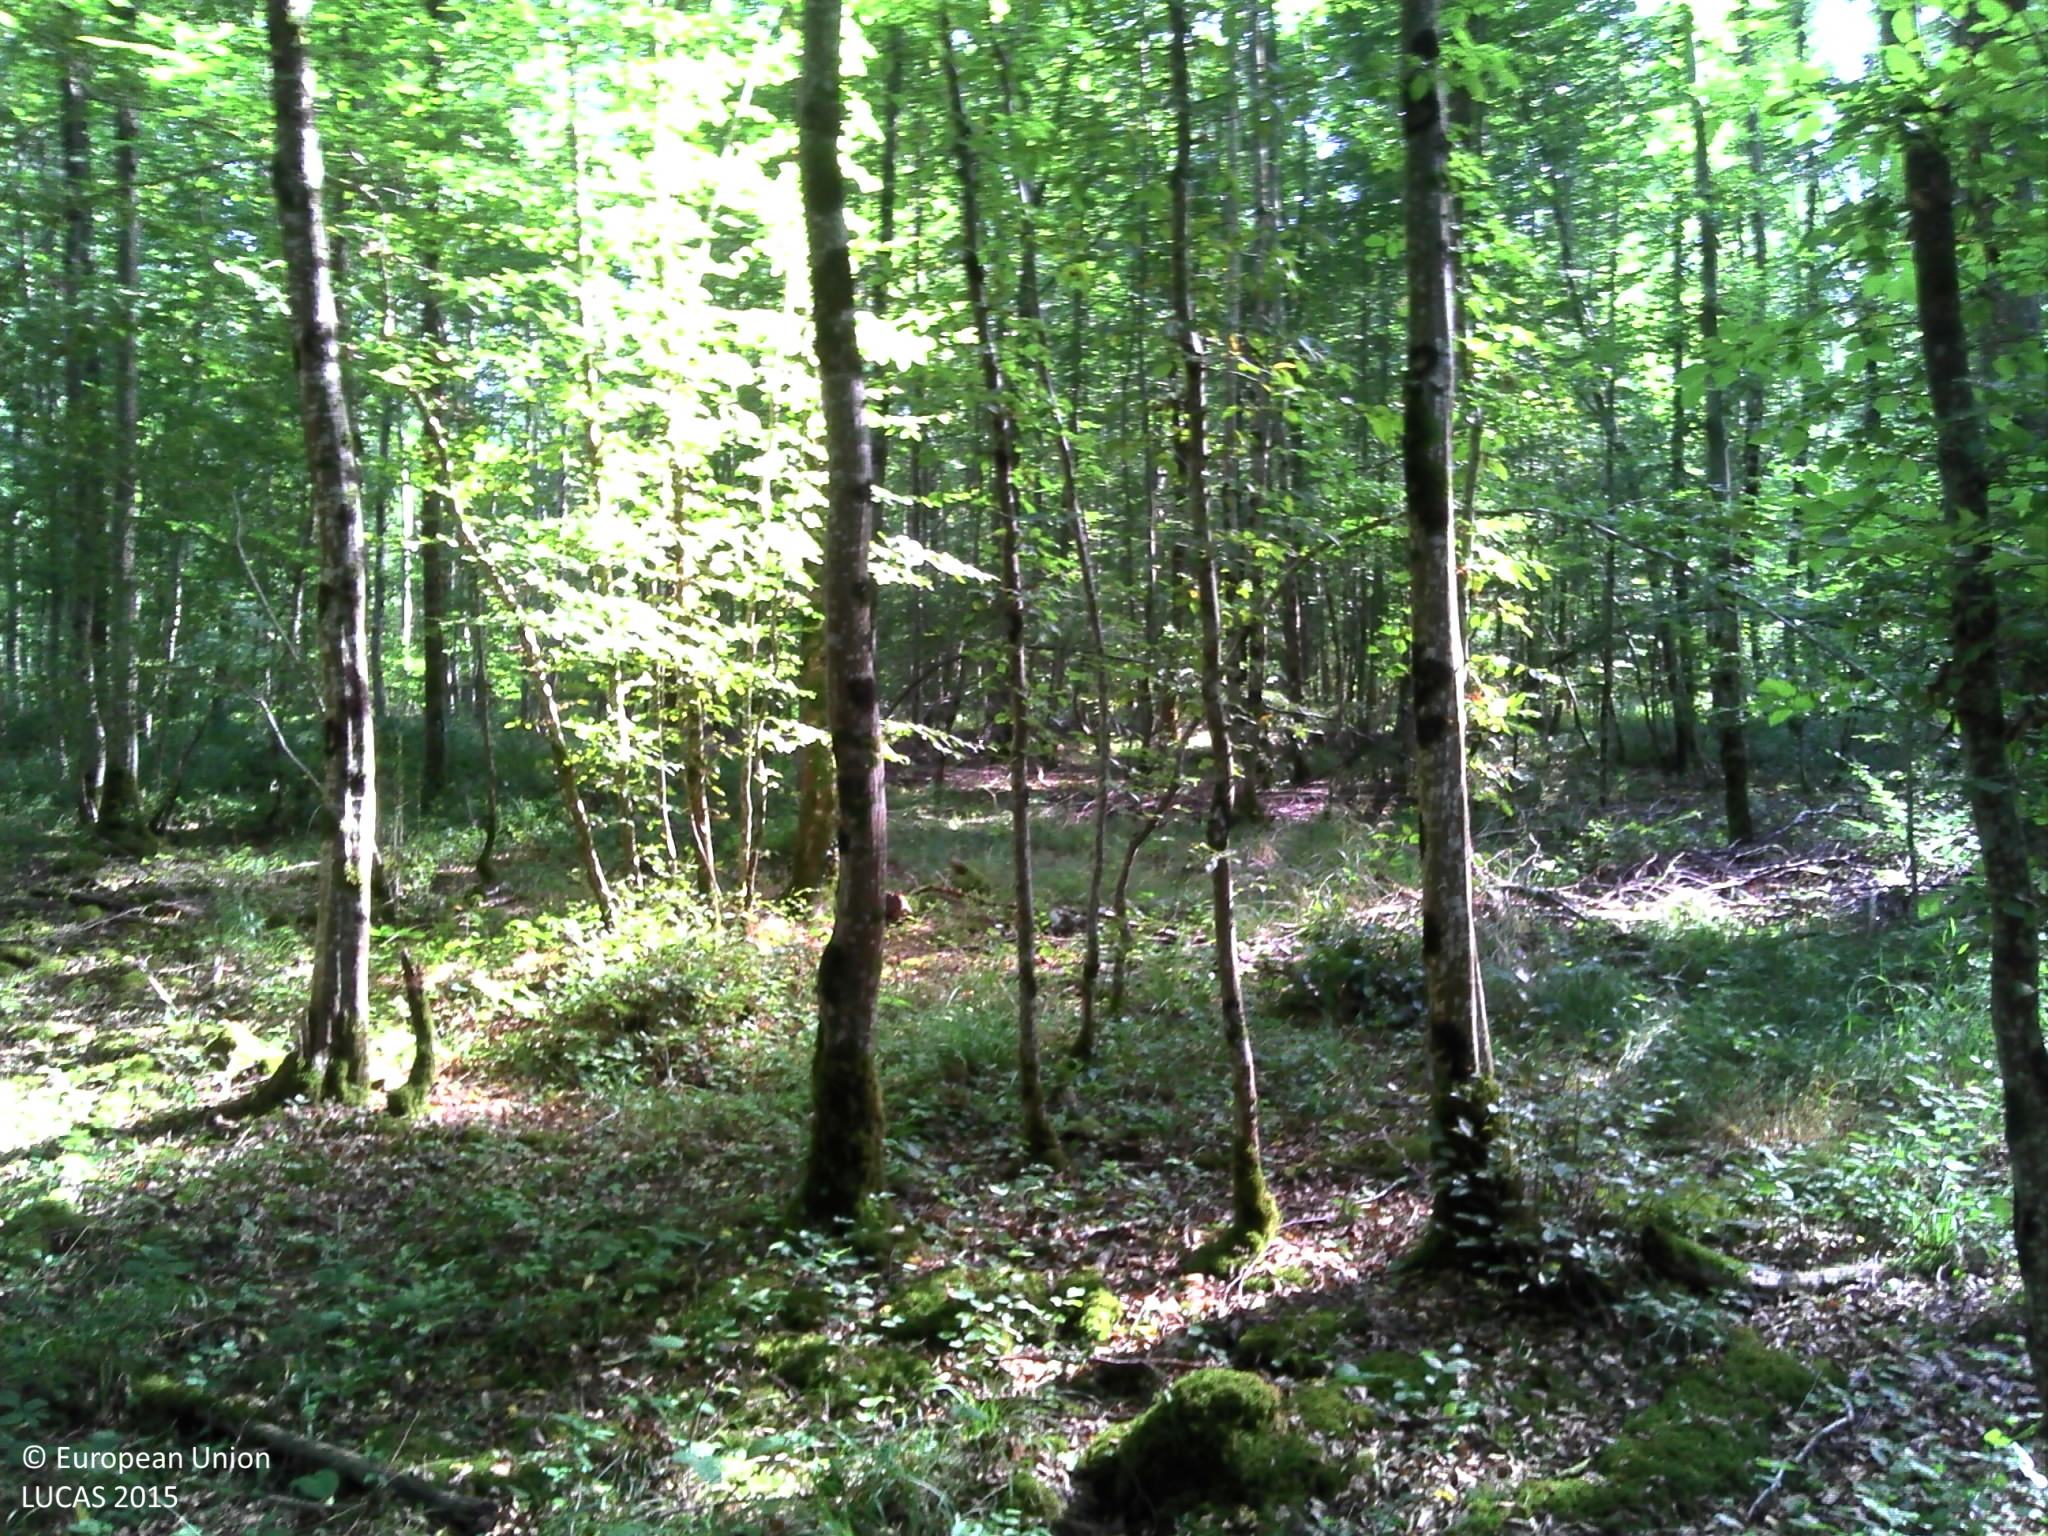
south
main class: Woodland
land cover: Broadleaved woodland
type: mesophytic deciduous forest
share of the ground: > 75 %
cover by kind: broadleaved forest trees 90 %, herbaceous plants 5 %, lichens and mosses 5 %
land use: Forestry
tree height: > 5 m
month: August
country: FR
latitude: 47.7869
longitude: 4.6463
